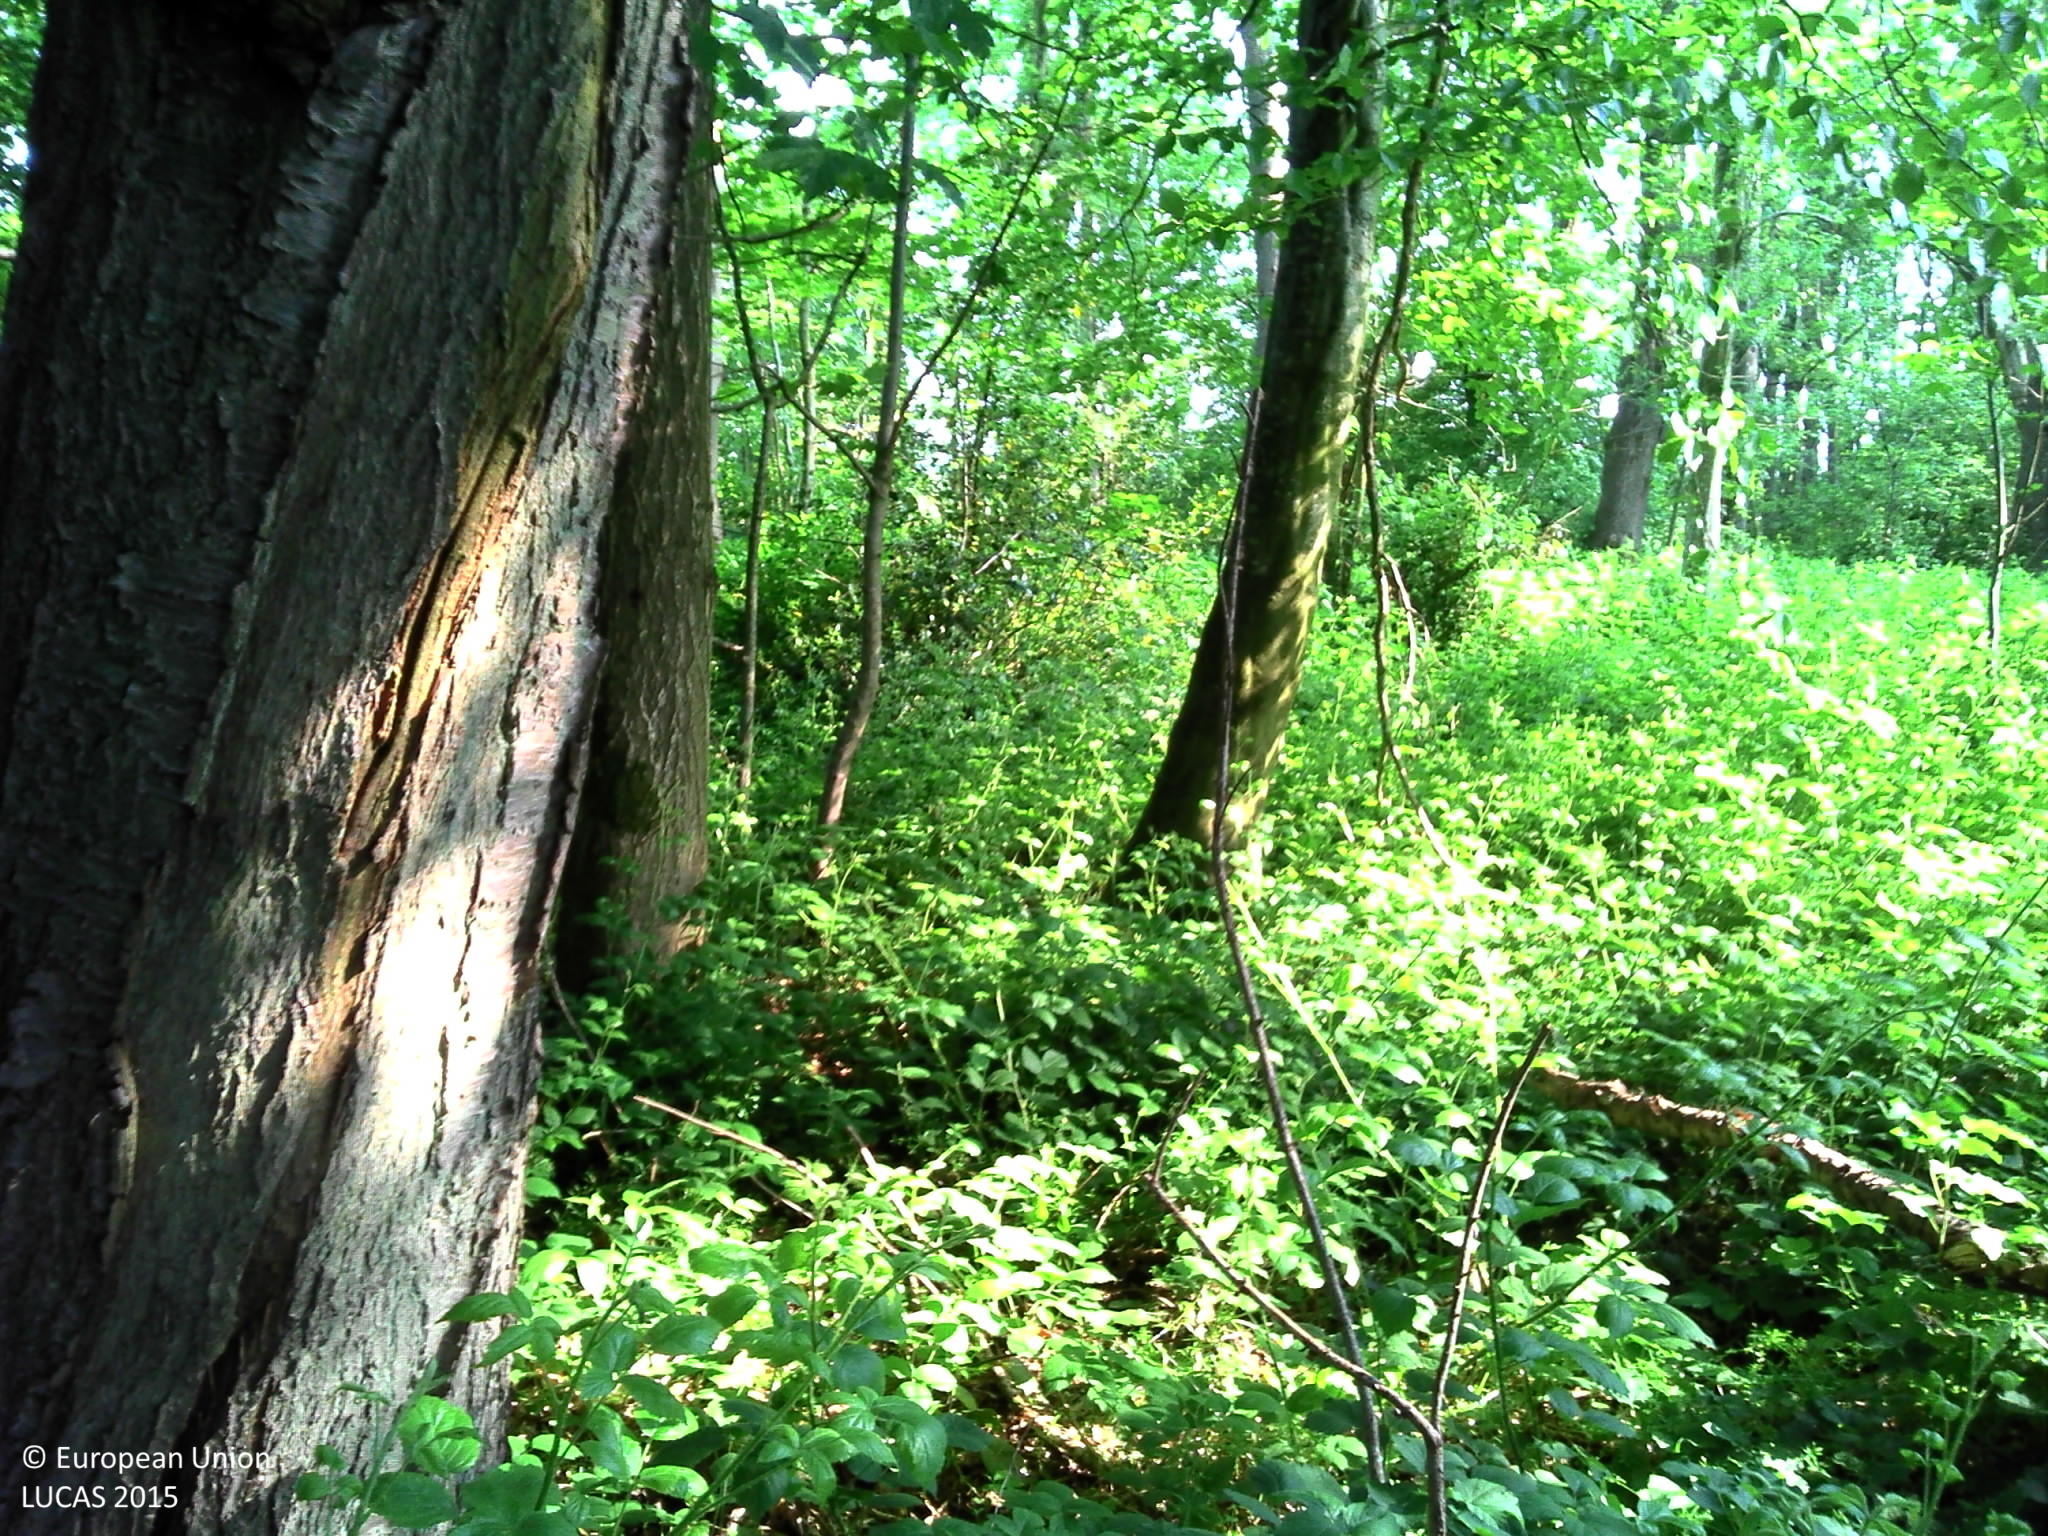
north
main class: Woodland
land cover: Broadleaved woodland
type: mesophytic deciduous forest
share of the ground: > 75 %
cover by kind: broadleaved forest trees 90 %, herbaceous plants 5 %
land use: Forestry
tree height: > 5 m
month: June
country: FR
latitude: 50.5401
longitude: 2.0688
